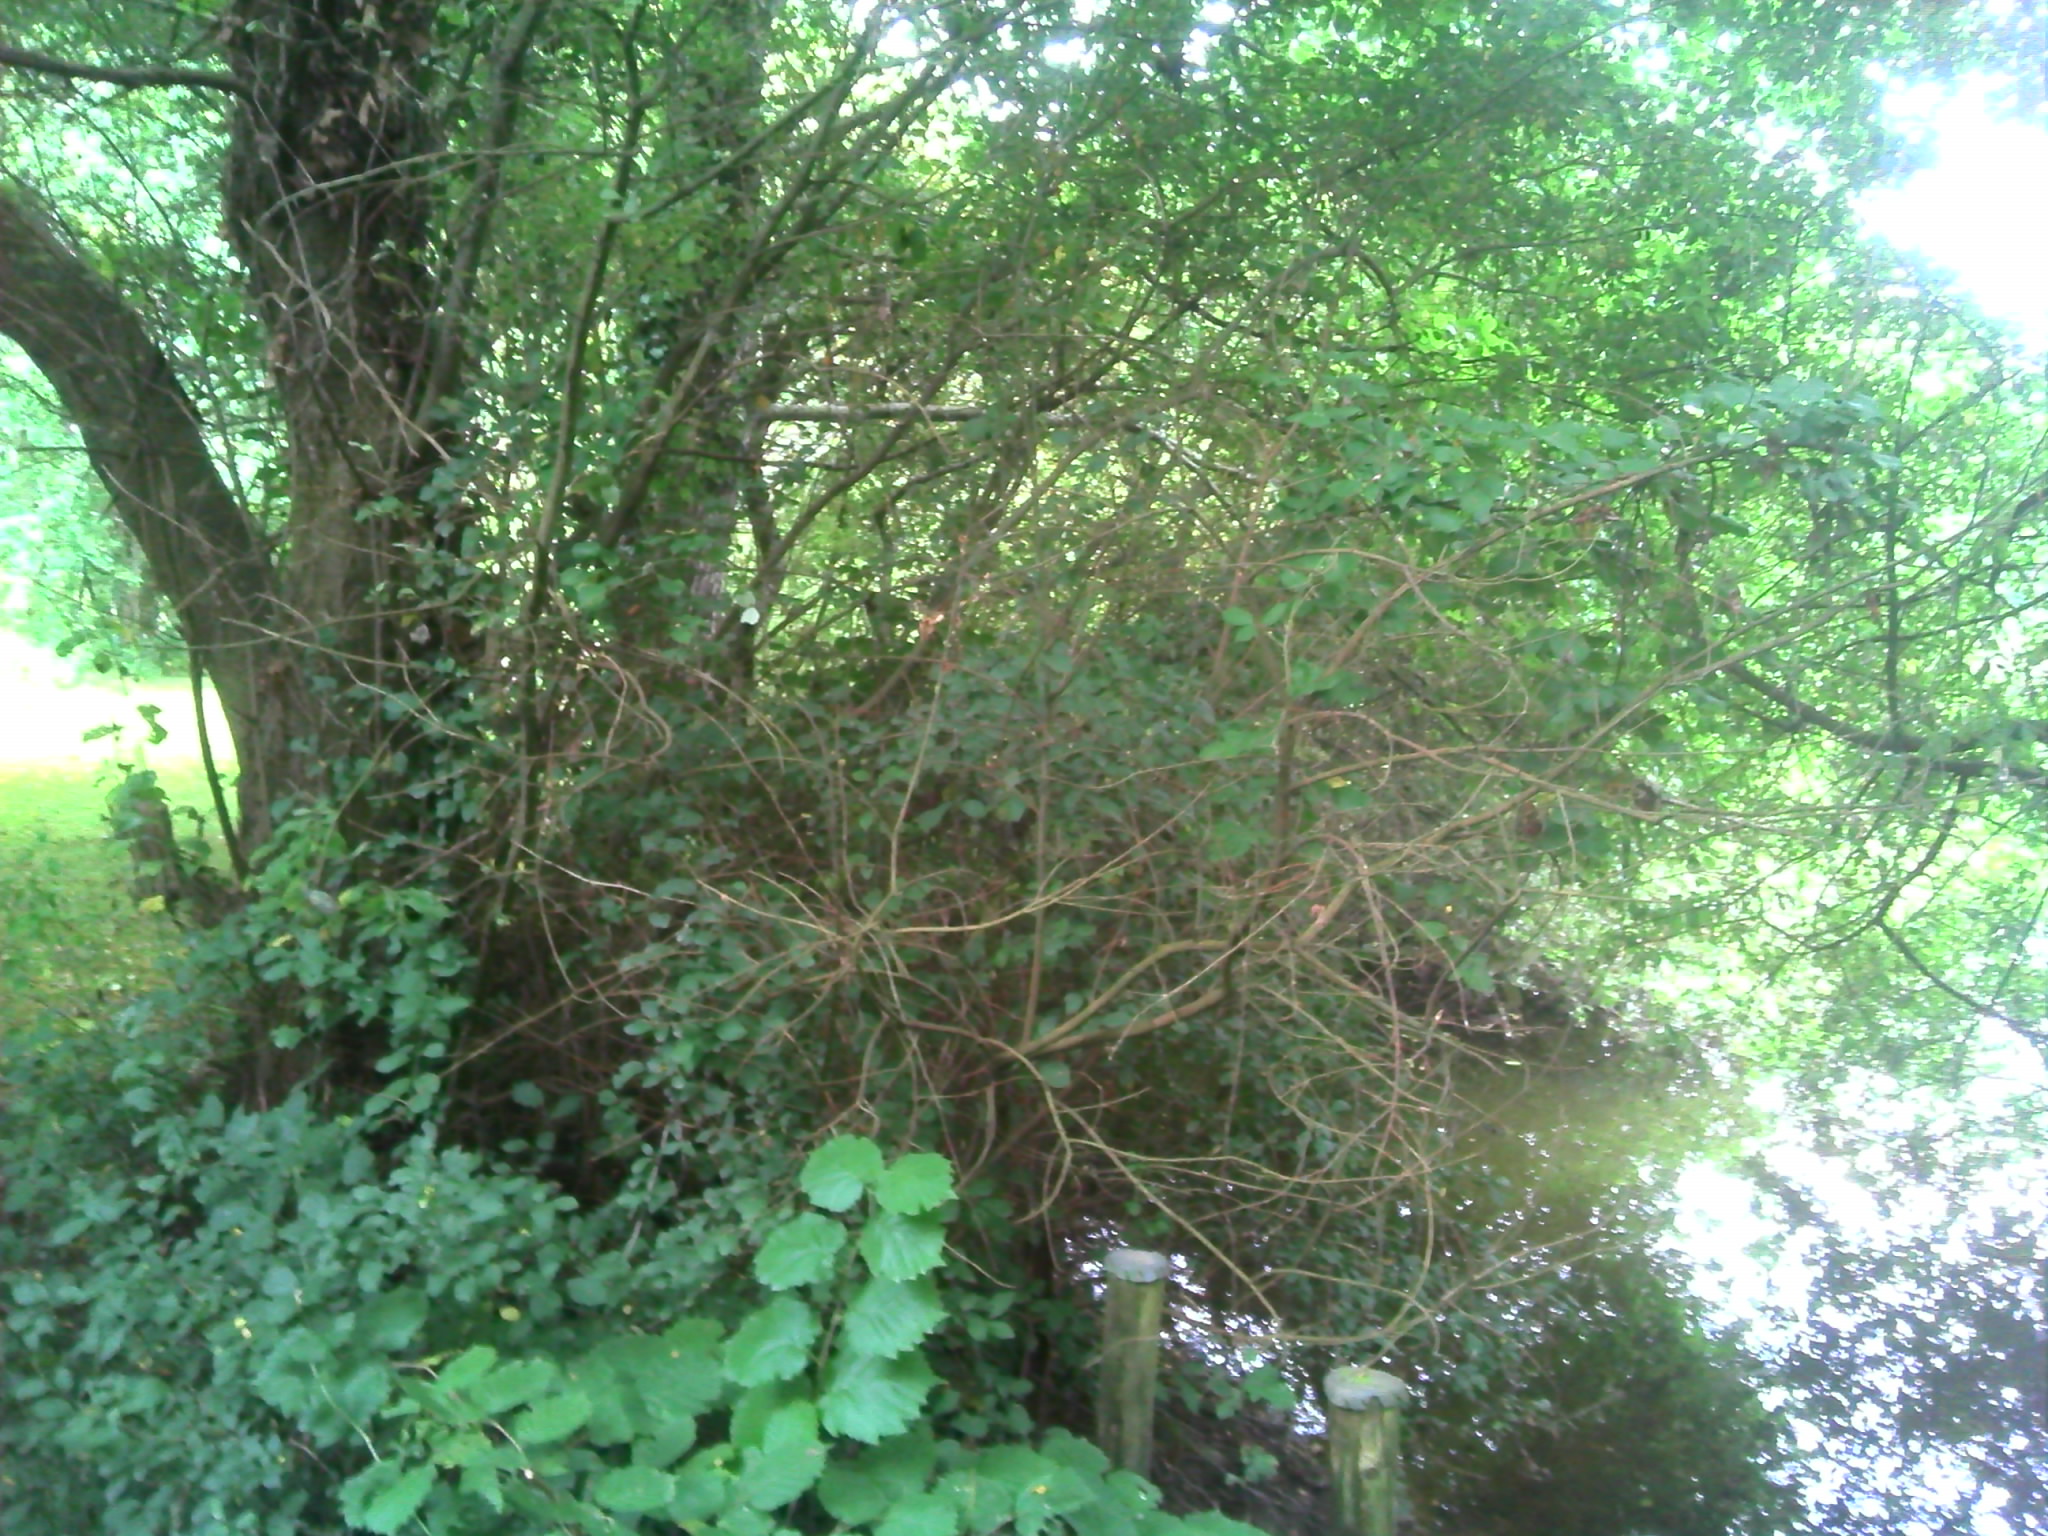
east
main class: Woodland
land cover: Broadleaved woodland
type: mesophytic deciduous forest
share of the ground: > 75 %
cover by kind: broadleaved forest trees 100 %
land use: Residential
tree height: > 5 m
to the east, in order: Tracks; Broadleaved woodland; Inland fresh water bodies; Broadleaved woodland; Tracks; Broadleaved woodland; Tracks; Grassland with sparse tree/shrub cover; Managed hedges; Grassland with sparse tree/shrub cover
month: August
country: FR
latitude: 46.6777
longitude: -1.6361
